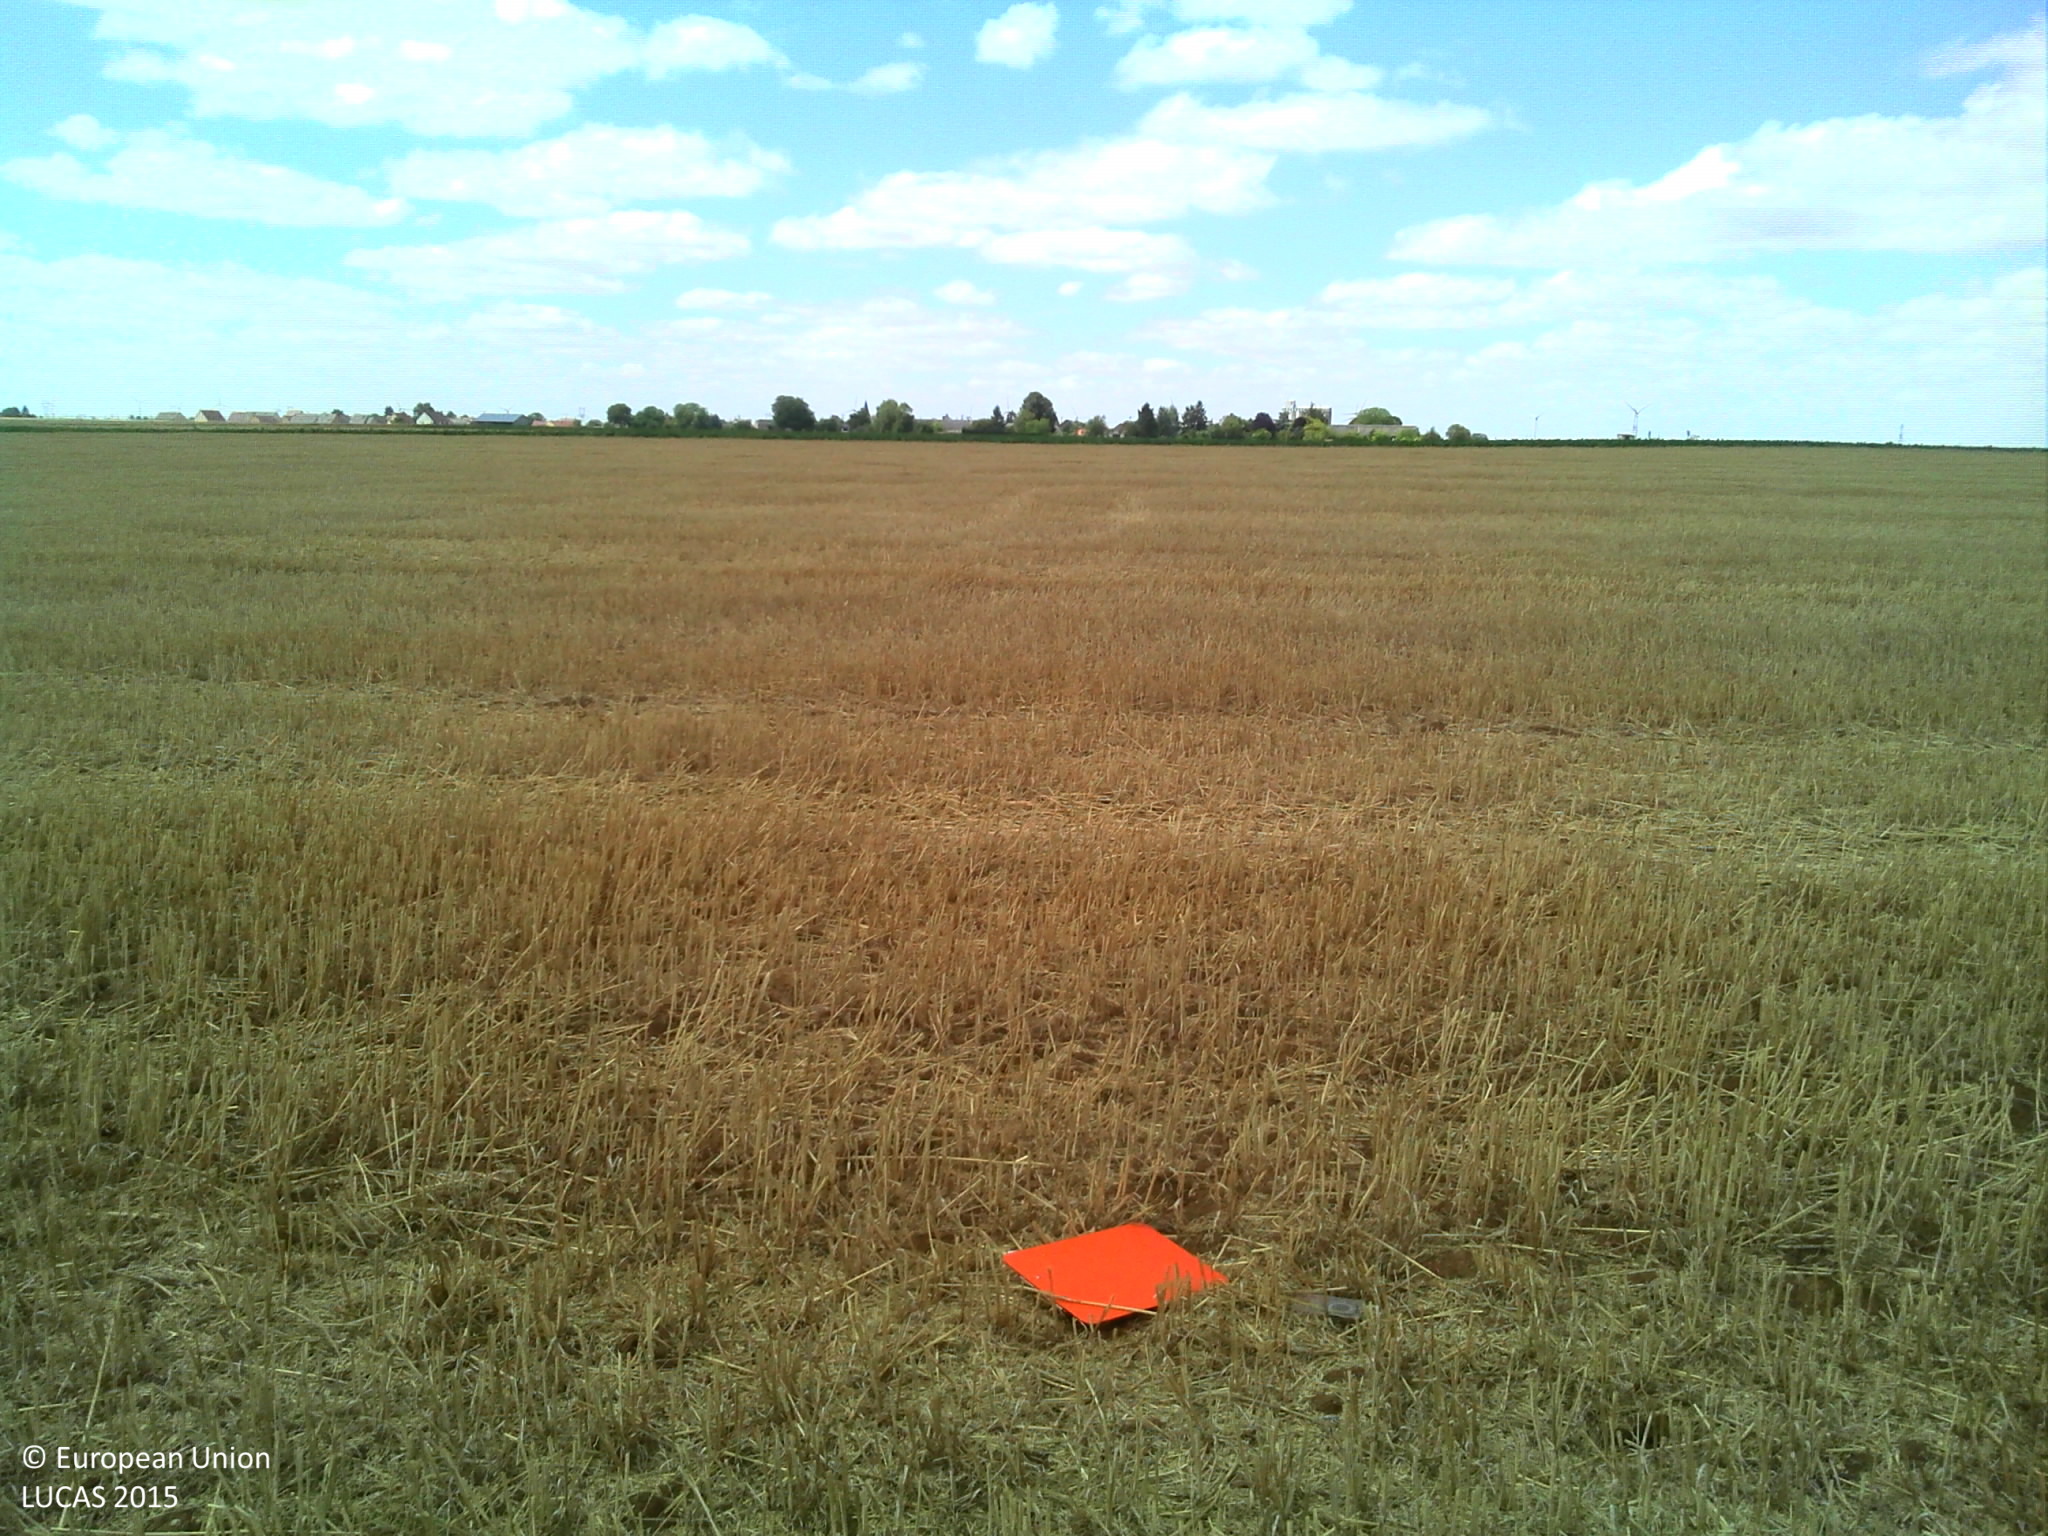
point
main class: Cropland
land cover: Common wheat
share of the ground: > 75 %
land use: Agriculture (excluding fallow land and kitchen gardens)
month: August
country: FR
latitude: 48.2579
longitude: 1.9995
